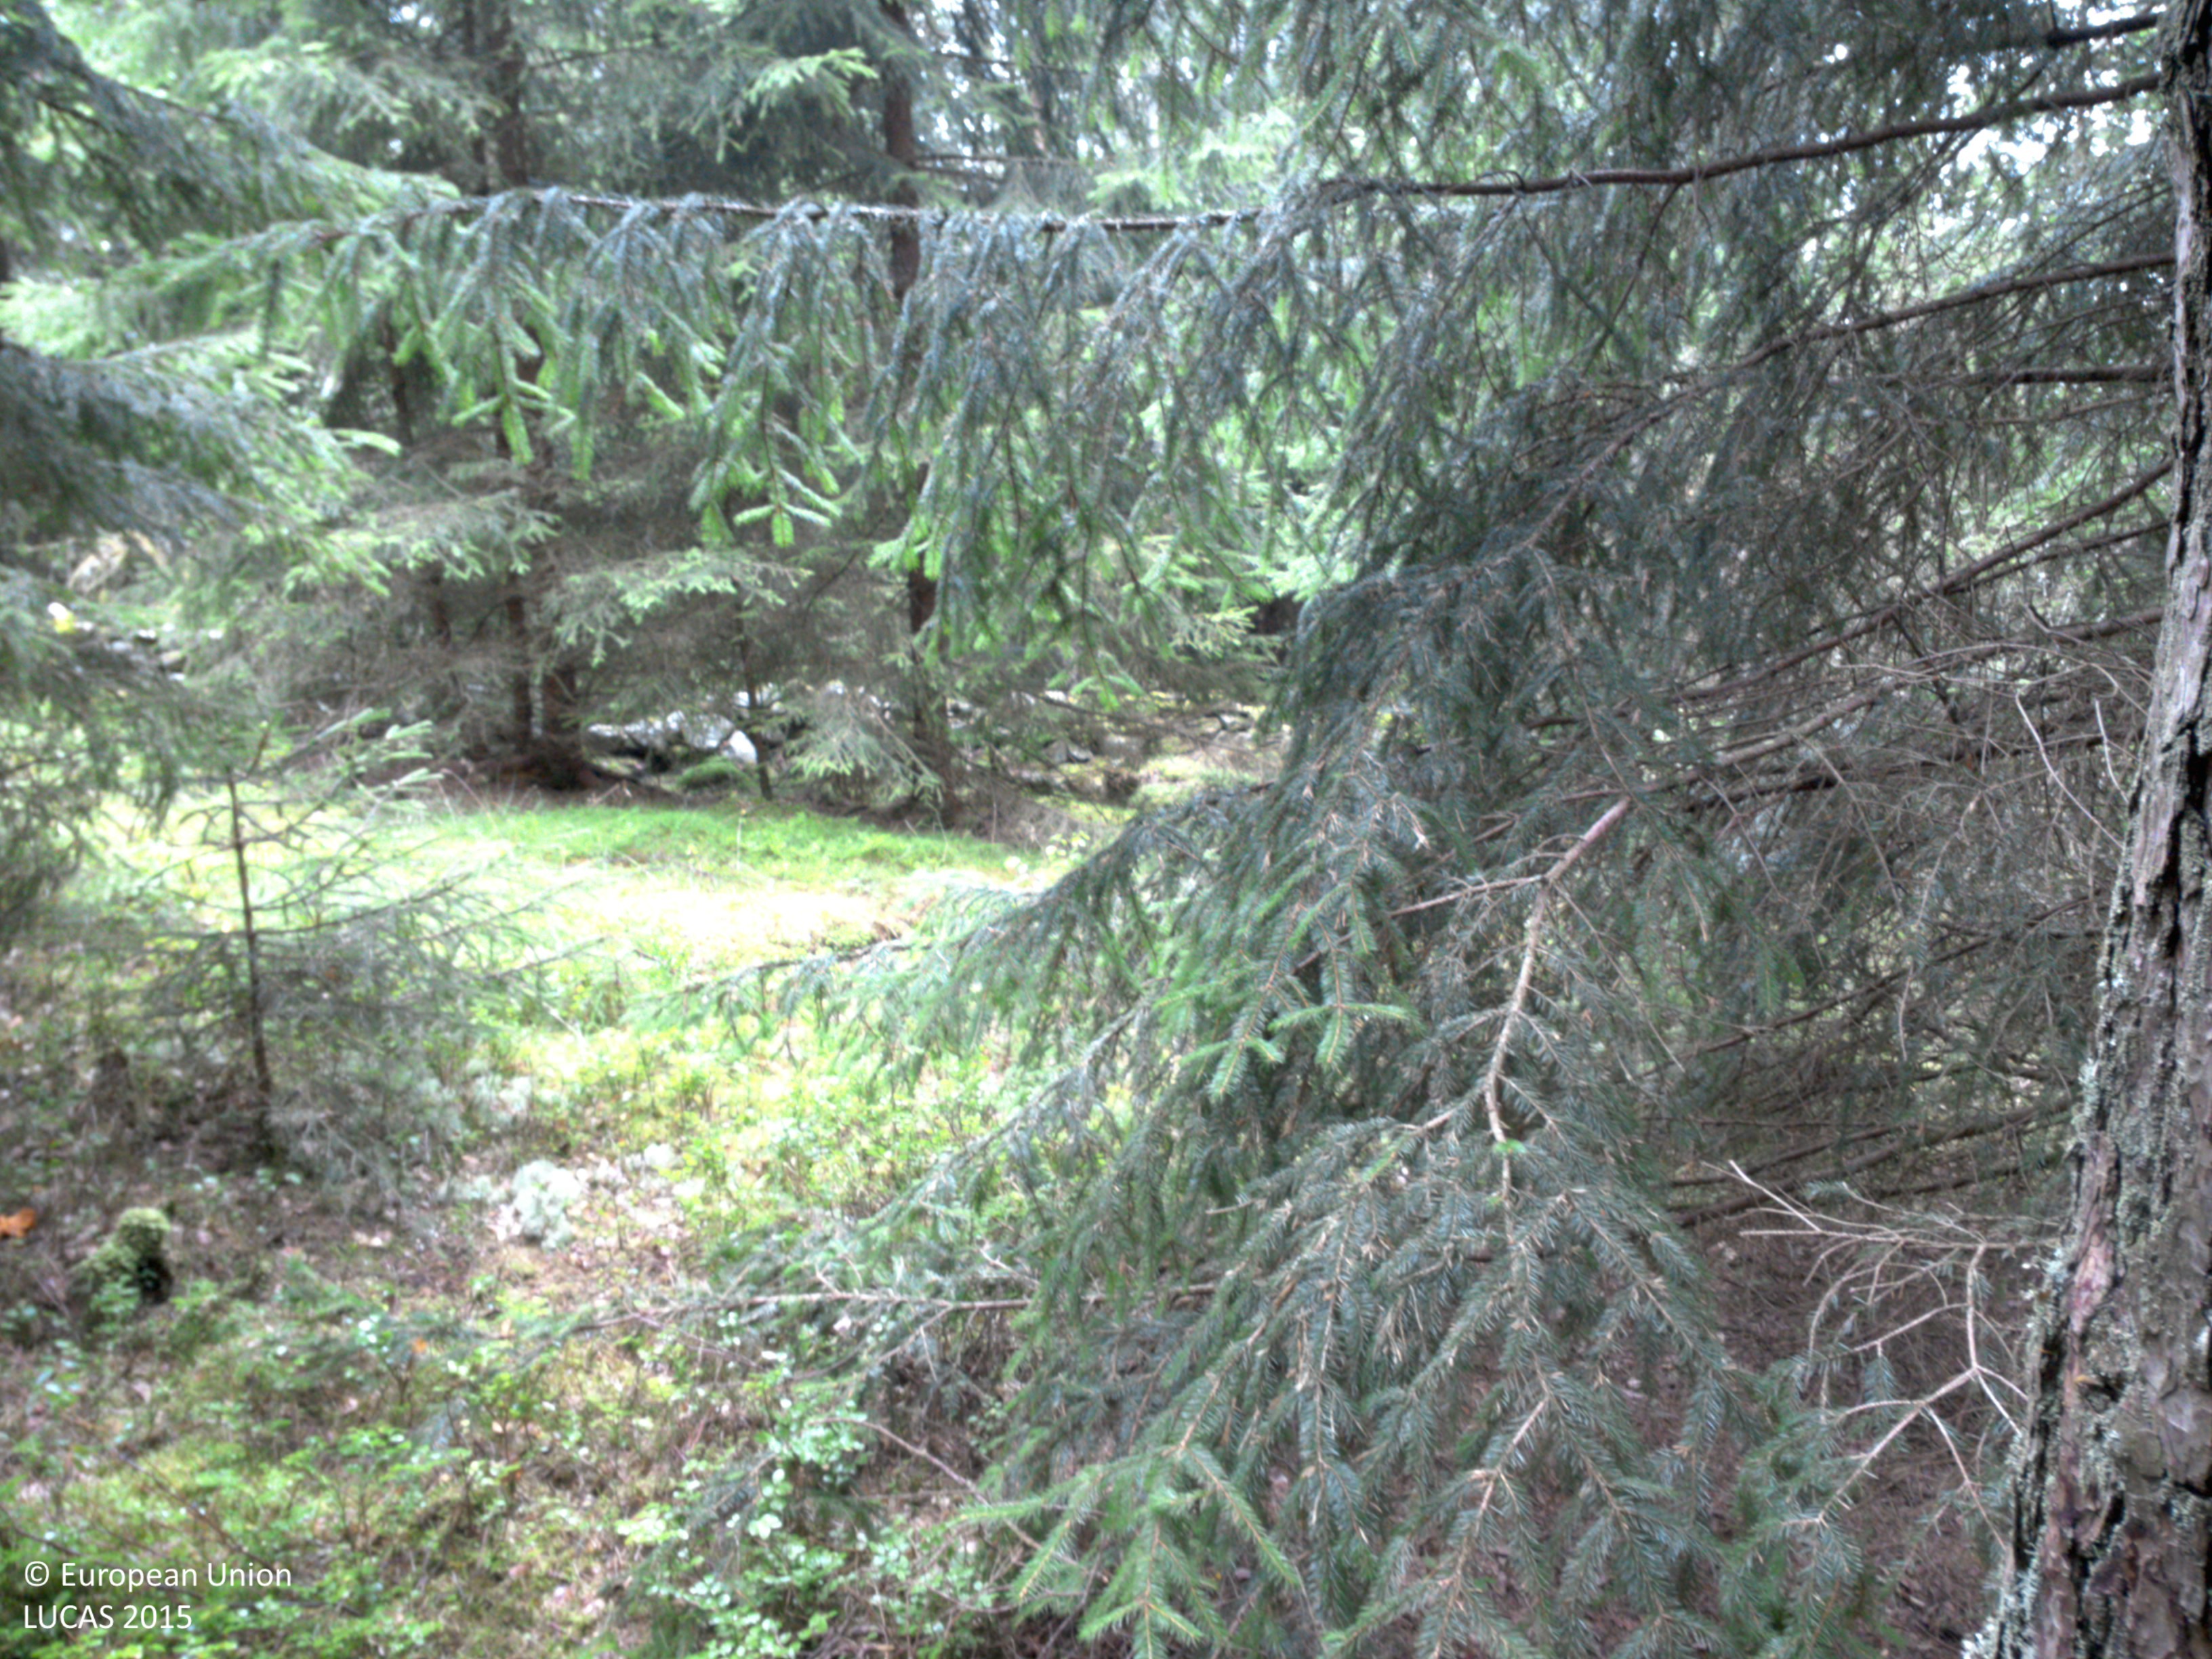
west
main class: Woodland
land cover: Other coniferous woodland
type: boreal forest
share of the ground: 50 - 75 %
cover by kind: coniferous forest trees 70 %, herbaceous plants 15 %, lichens and mosses 10 %, shrubs 5 %
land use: Forestry
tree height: > 5 m
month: August
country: SE
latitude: 57.9191
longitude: 11.8367
